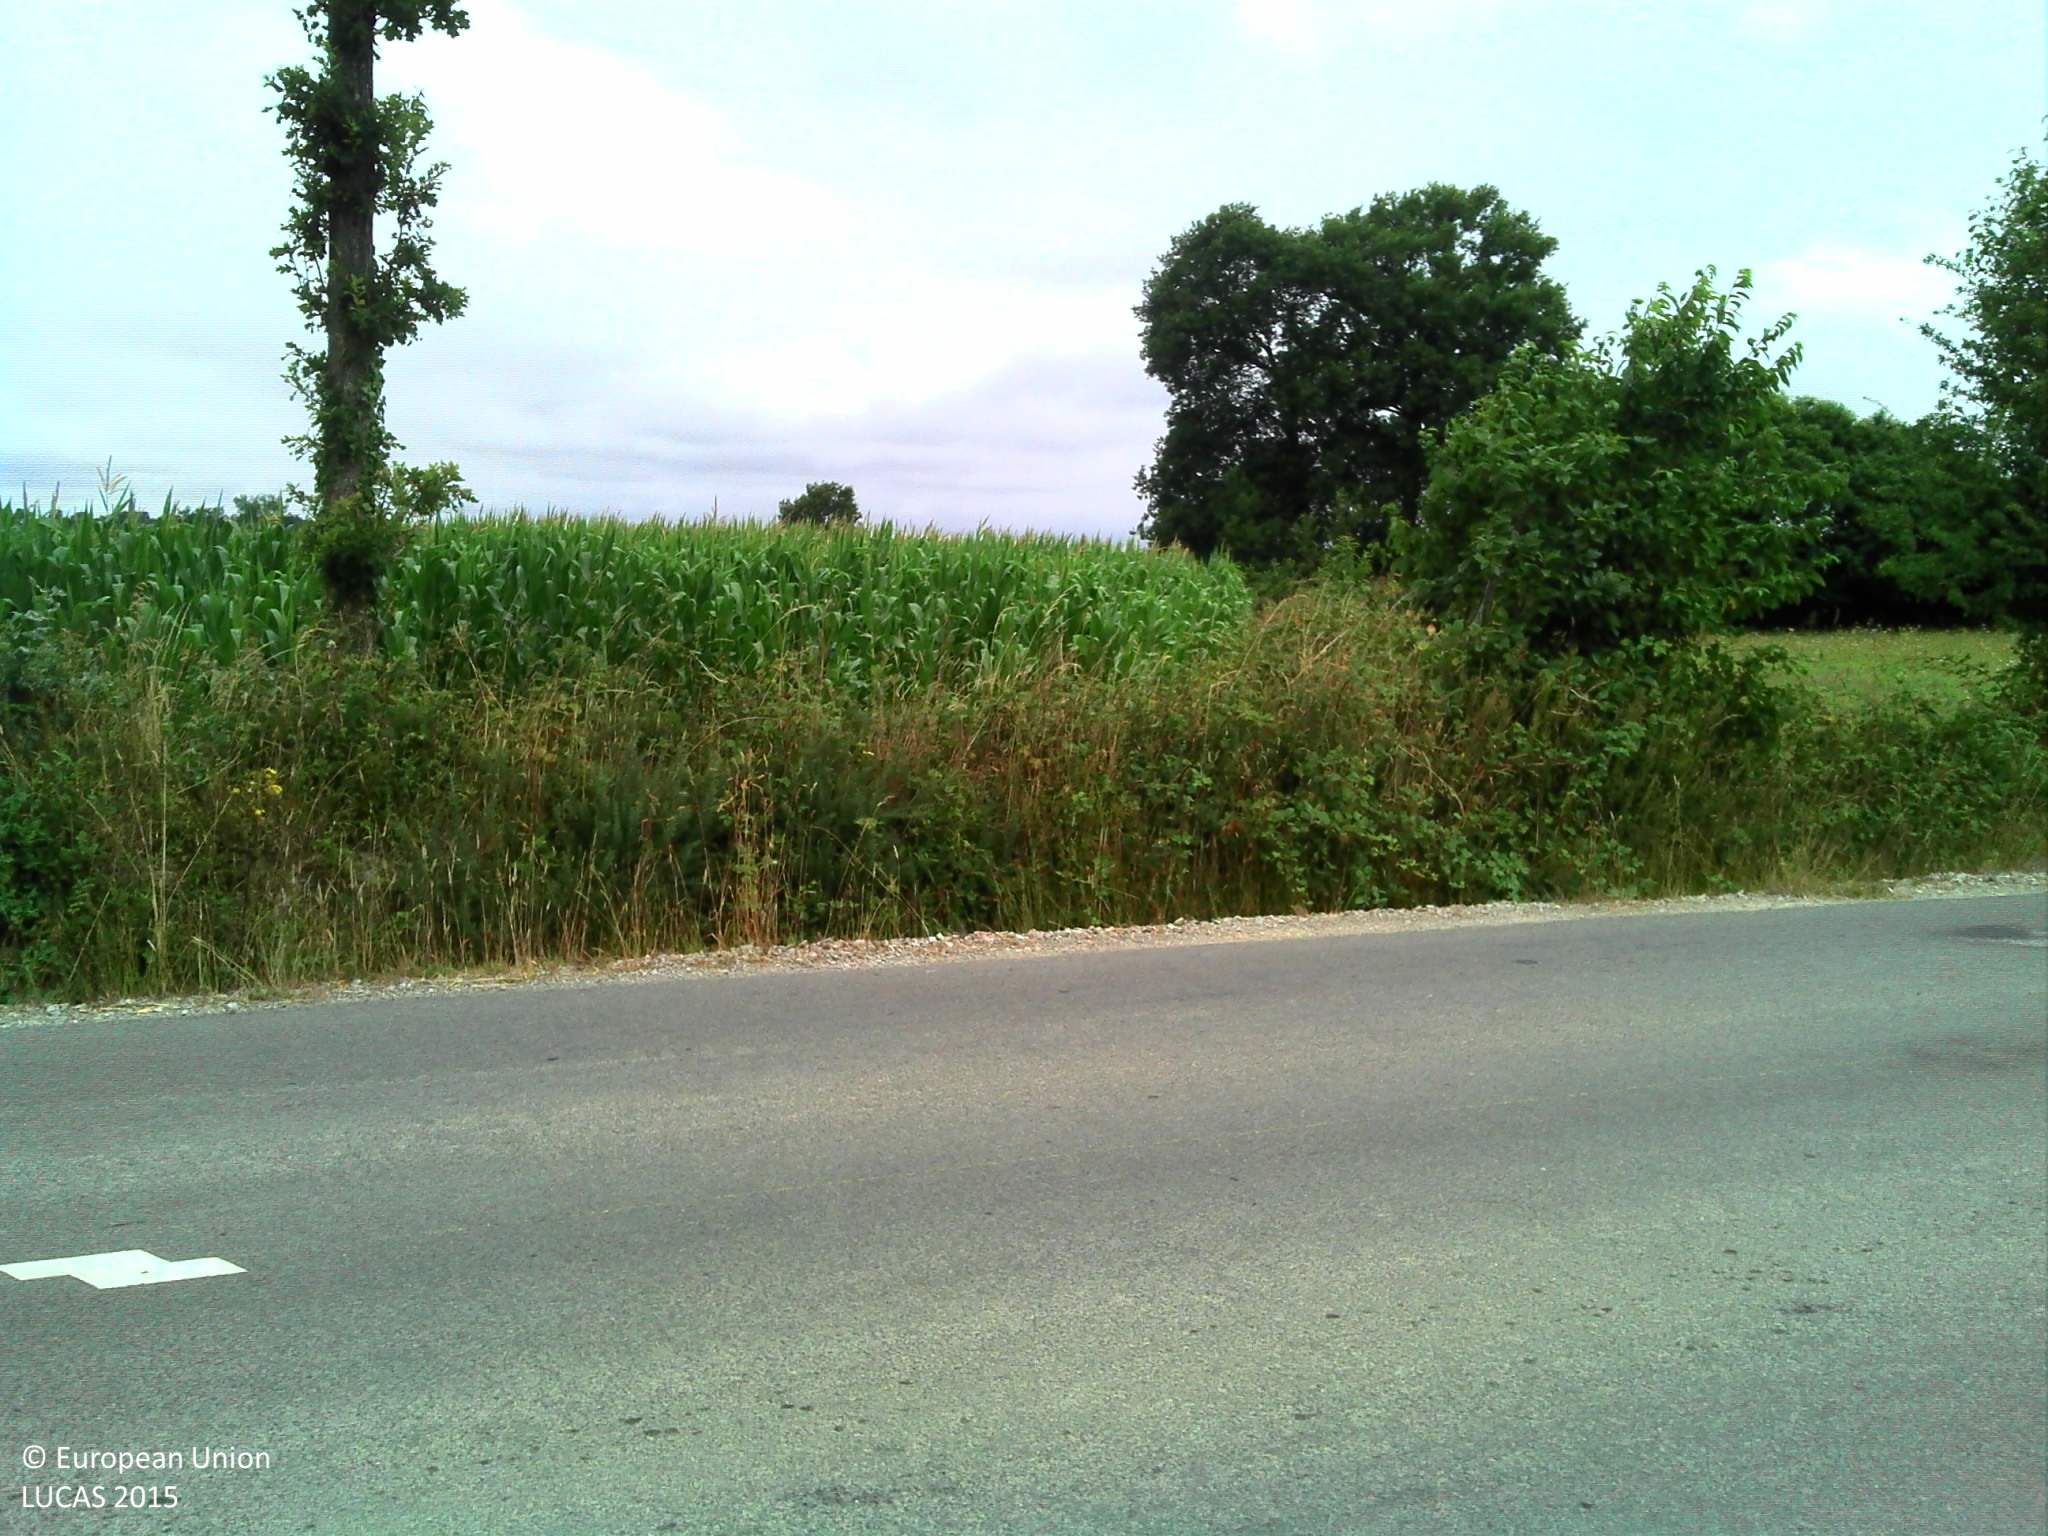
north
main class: Grassland
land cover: Grassland without tree/shrub cover
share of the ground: > 75 %
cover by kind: herbaceous plants 100 %
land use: Residential
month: July
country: FR
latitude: 47.7709
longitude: -1.6147
